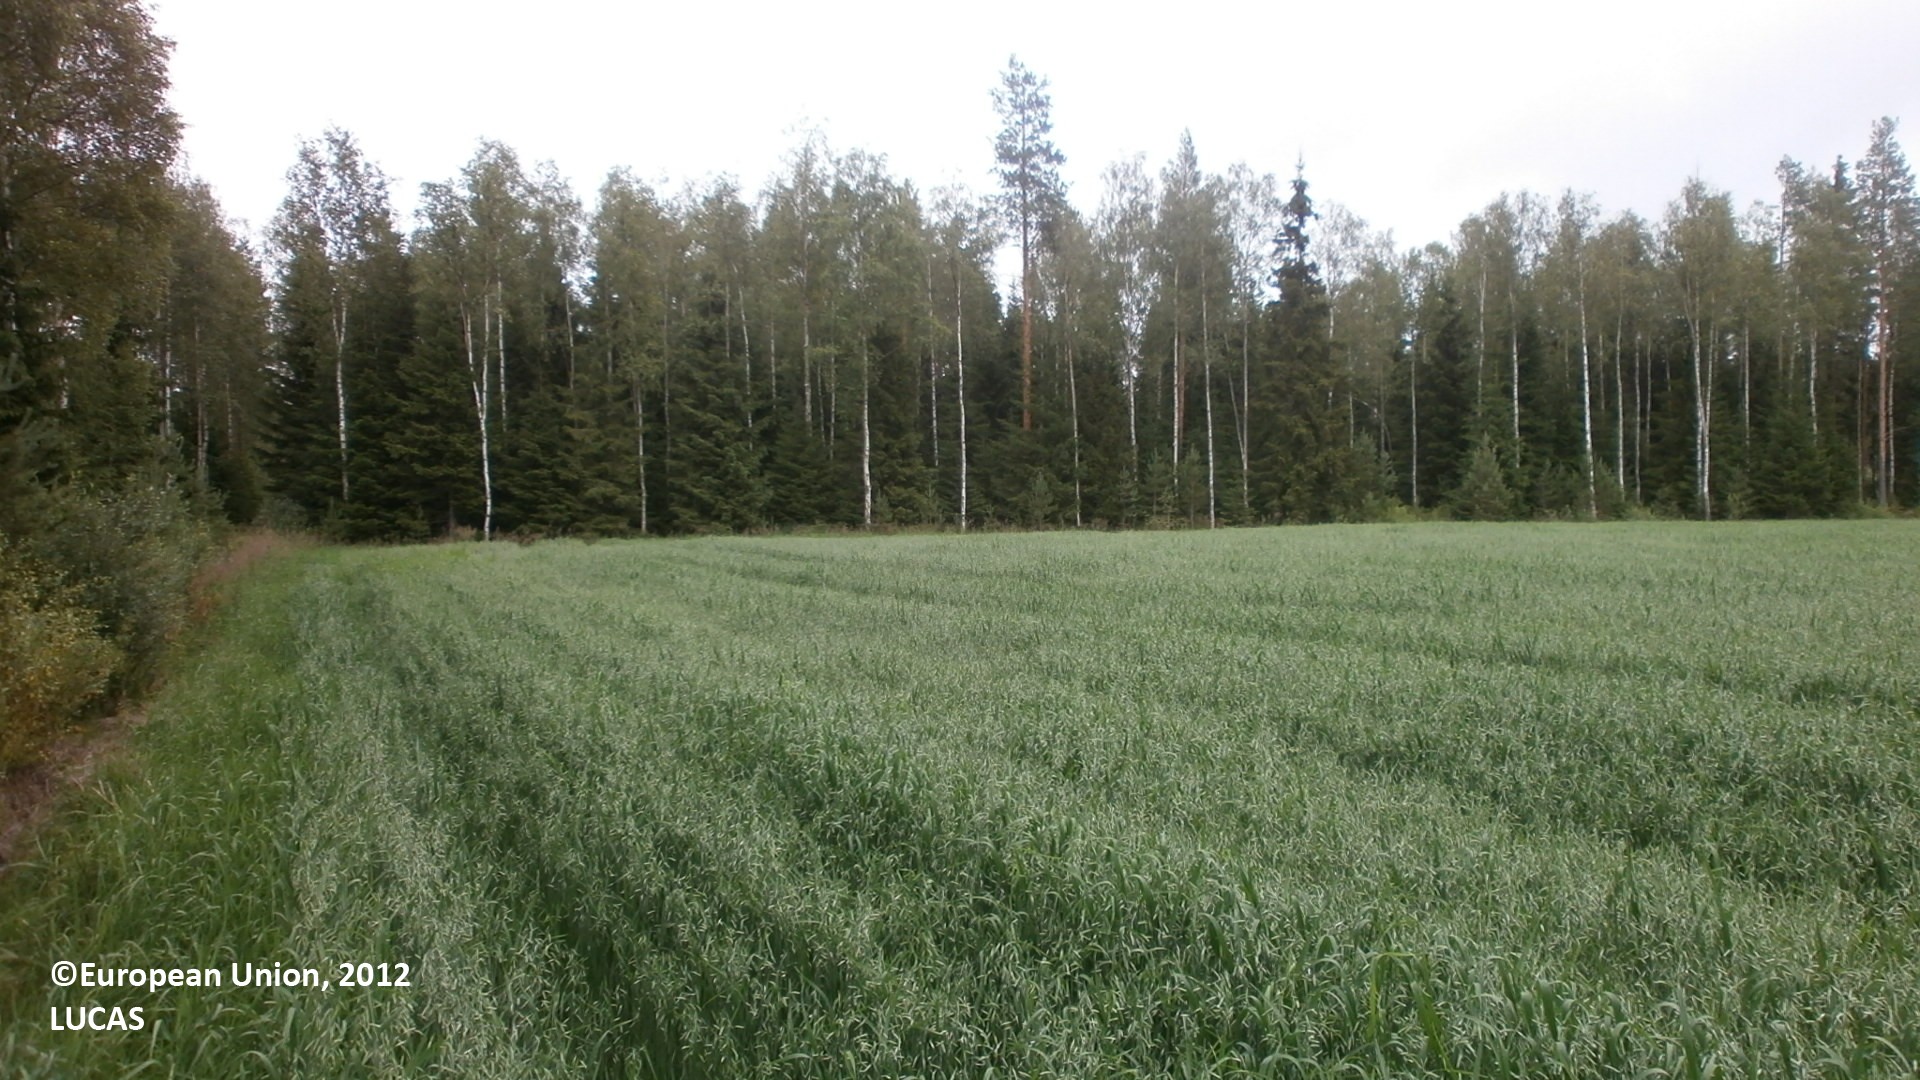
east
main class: Cropland
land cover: Oats
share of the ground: > 75 %
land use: Agriculture (excluding fallow land and kitchen gardens)
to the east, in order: Oats; Shruby margins; Ditches and canals; Spruce dominated mixed woodland; Tracks; Spruce dominated mixed woodland; Ditches and canals; Spruce dominated mixed woodland; Ditches and canals; Spruce dominated mixed woodland; Broadleaved woodland; Ditches and canals; Broadleaved woodland; Pine dominated mixed woodland; Ditches and canals; Pine dominated mixed woodland; Ditches and canals; Broadleaved woodland; Ditches and canals; Broadleaved woodland; Ditches and canals; Broadleaved woodland
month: July
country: FI
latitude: 64.2422
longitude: 24.1101
